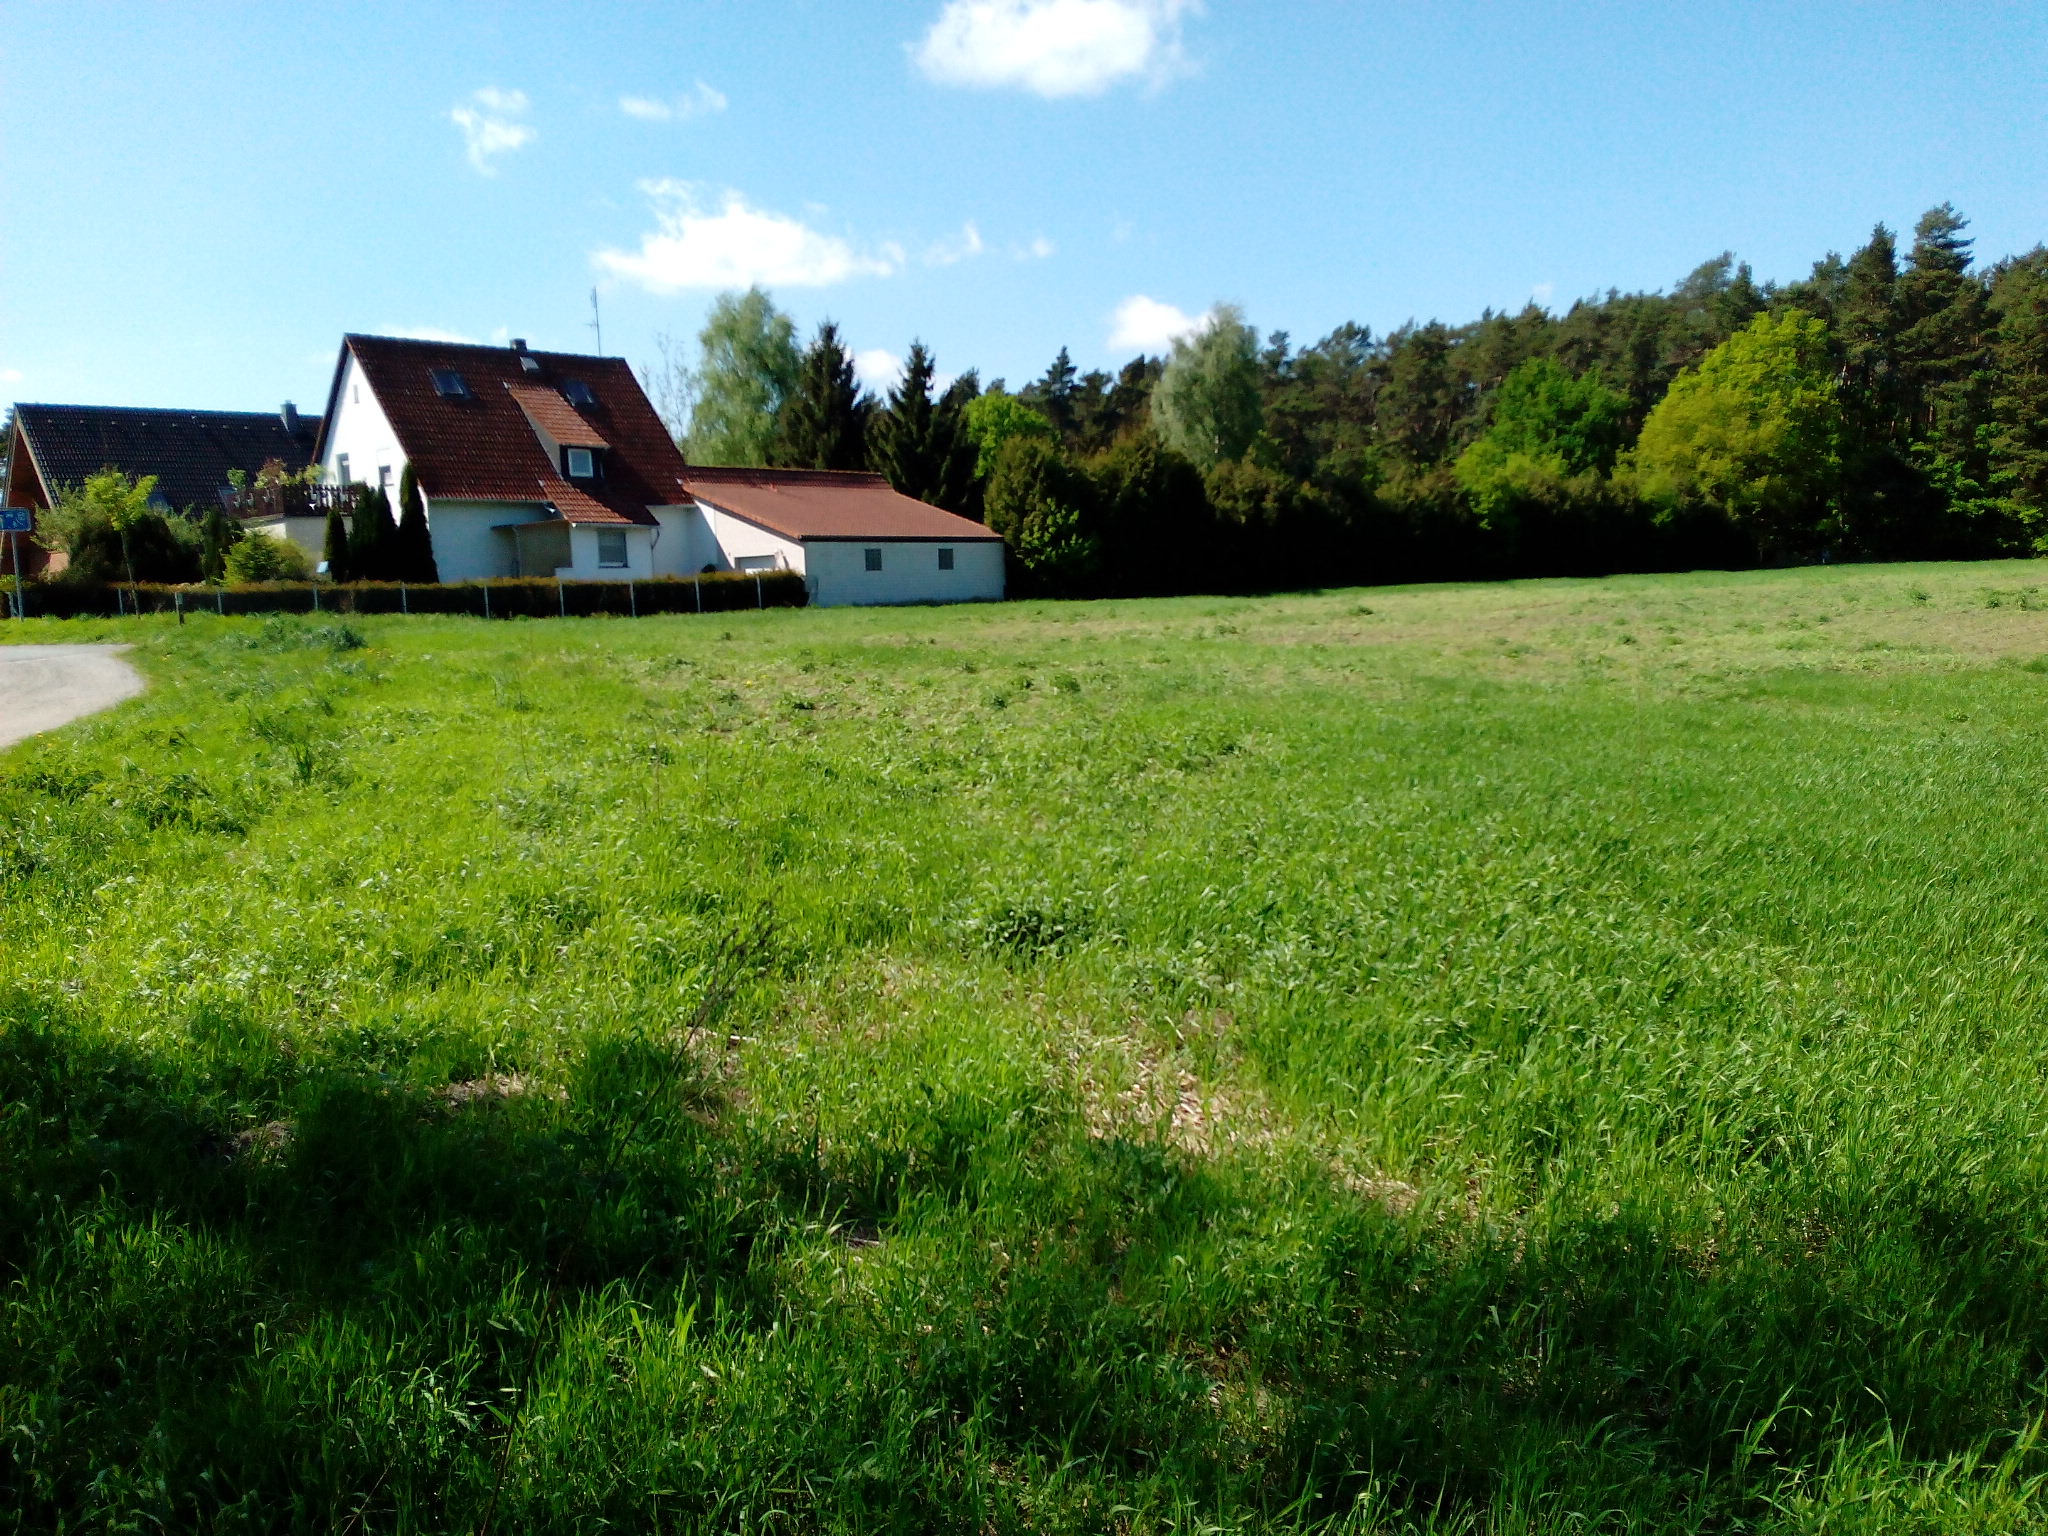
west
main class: Grassland
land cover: Grassland without tree/shrub cover
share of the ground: > 75 %
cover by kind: herbaceous plants 100 %
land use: Agriculture (excluding fallow land and kitchen gardens)
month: May
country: DE
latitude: 52.4673
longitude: 9.8970
